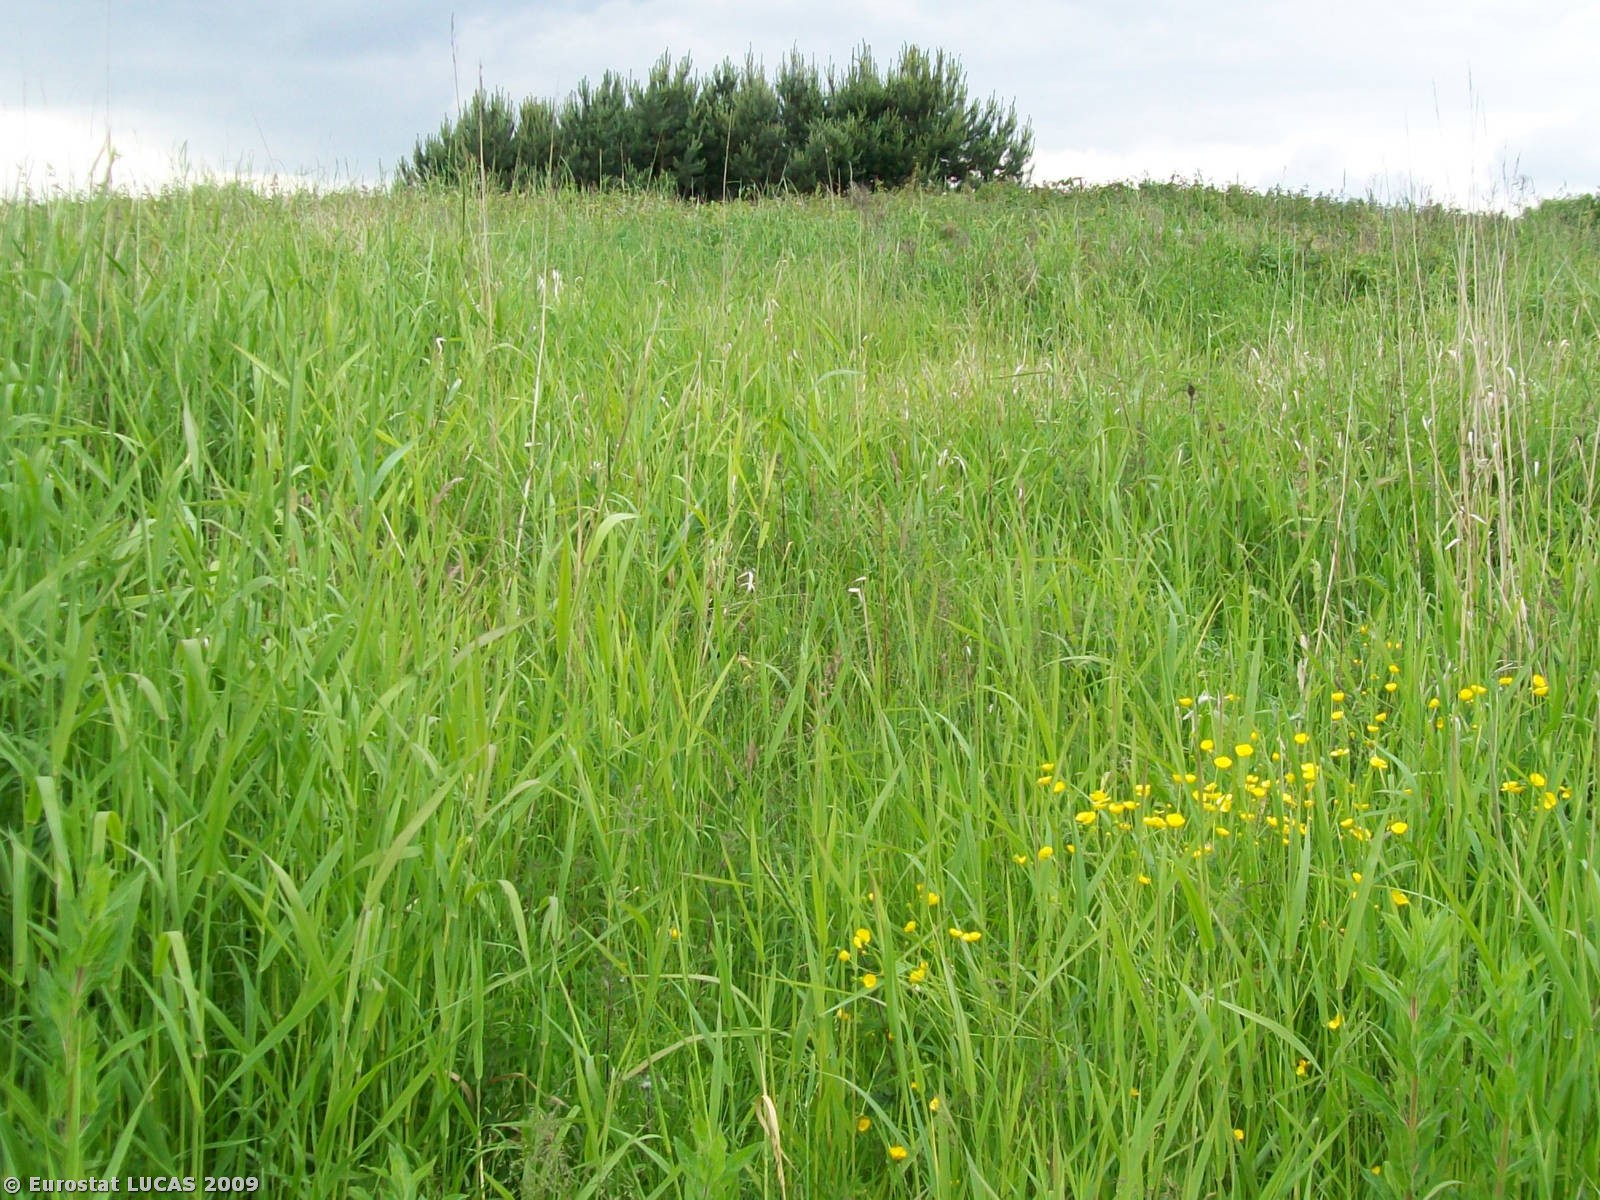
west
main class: Grassland
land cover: Grassland with sparse tree/shrub cover
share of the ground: < 10 %
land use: Amenities, museums, leisure
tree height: > 5 m
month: June
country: GB
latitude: 53.4099
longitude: -2.8128
